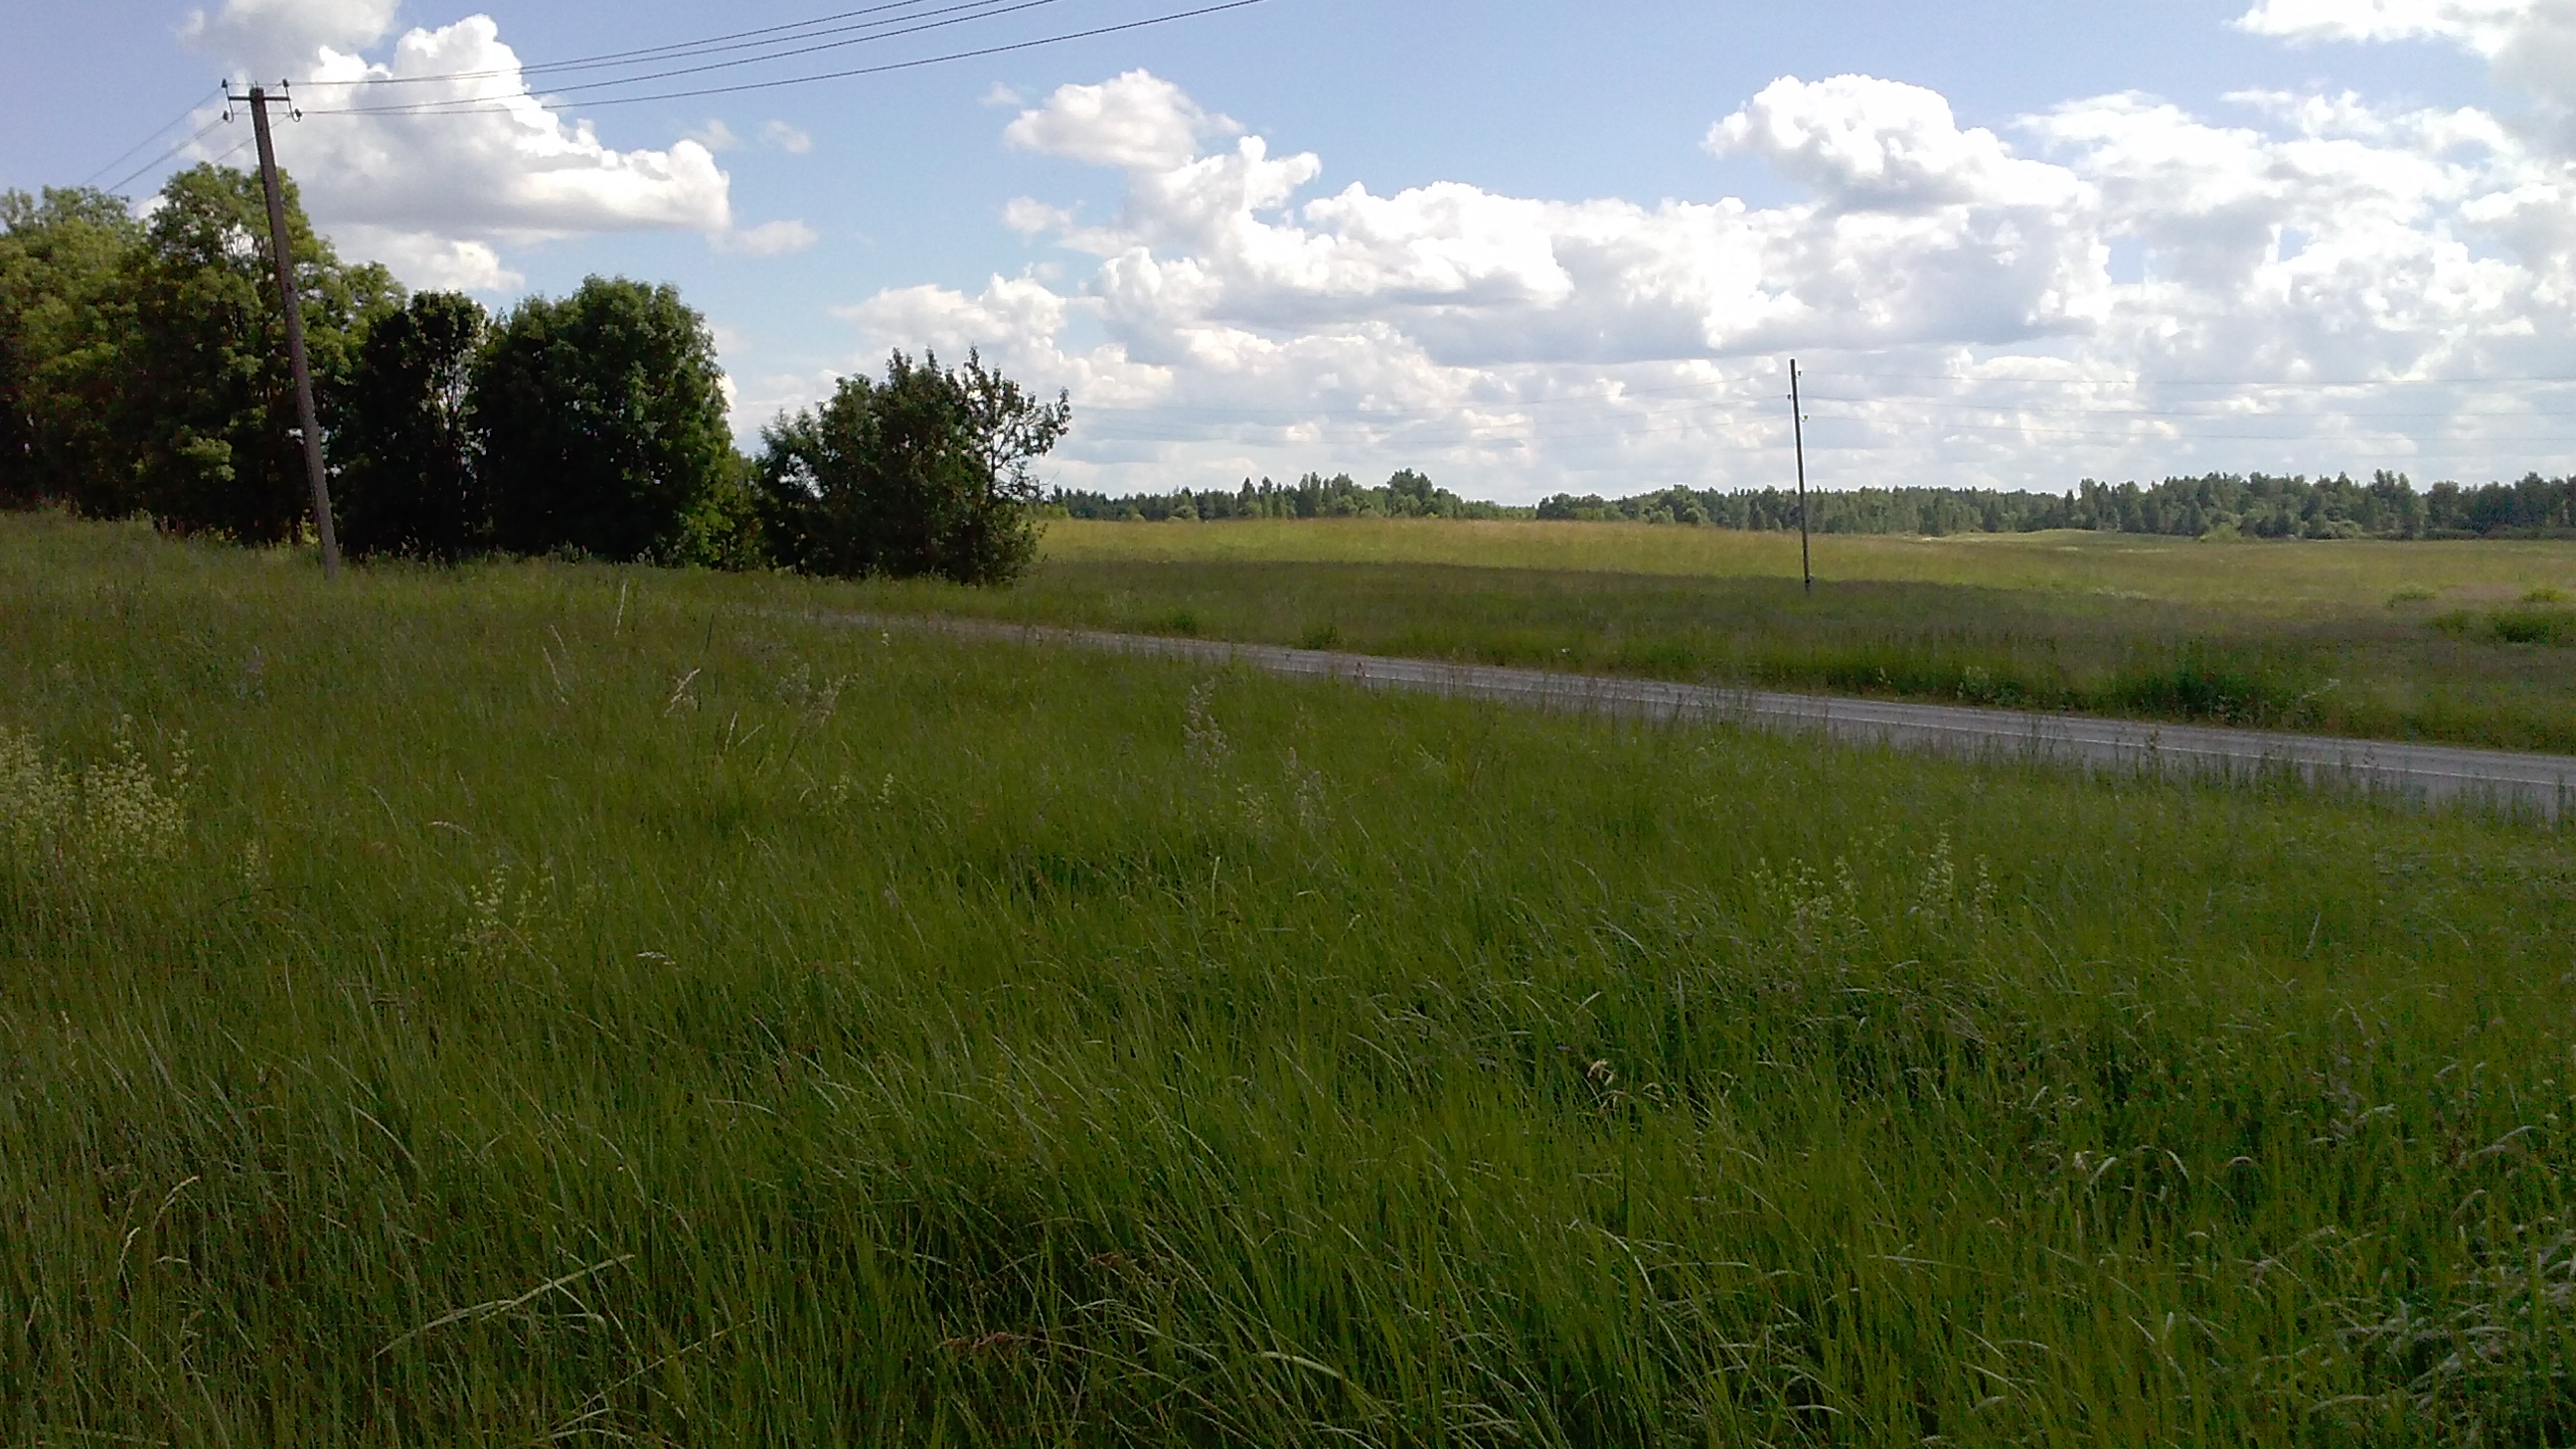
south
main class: Grassland
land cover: Grassland without tree/shrub cover
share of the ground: > 75 %
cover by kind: herbaceous plants 100 %
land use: Agriculture (excluding fallow land and kitchen gardens)
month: June
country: LV
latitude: 56.4825
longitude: 27.9088
